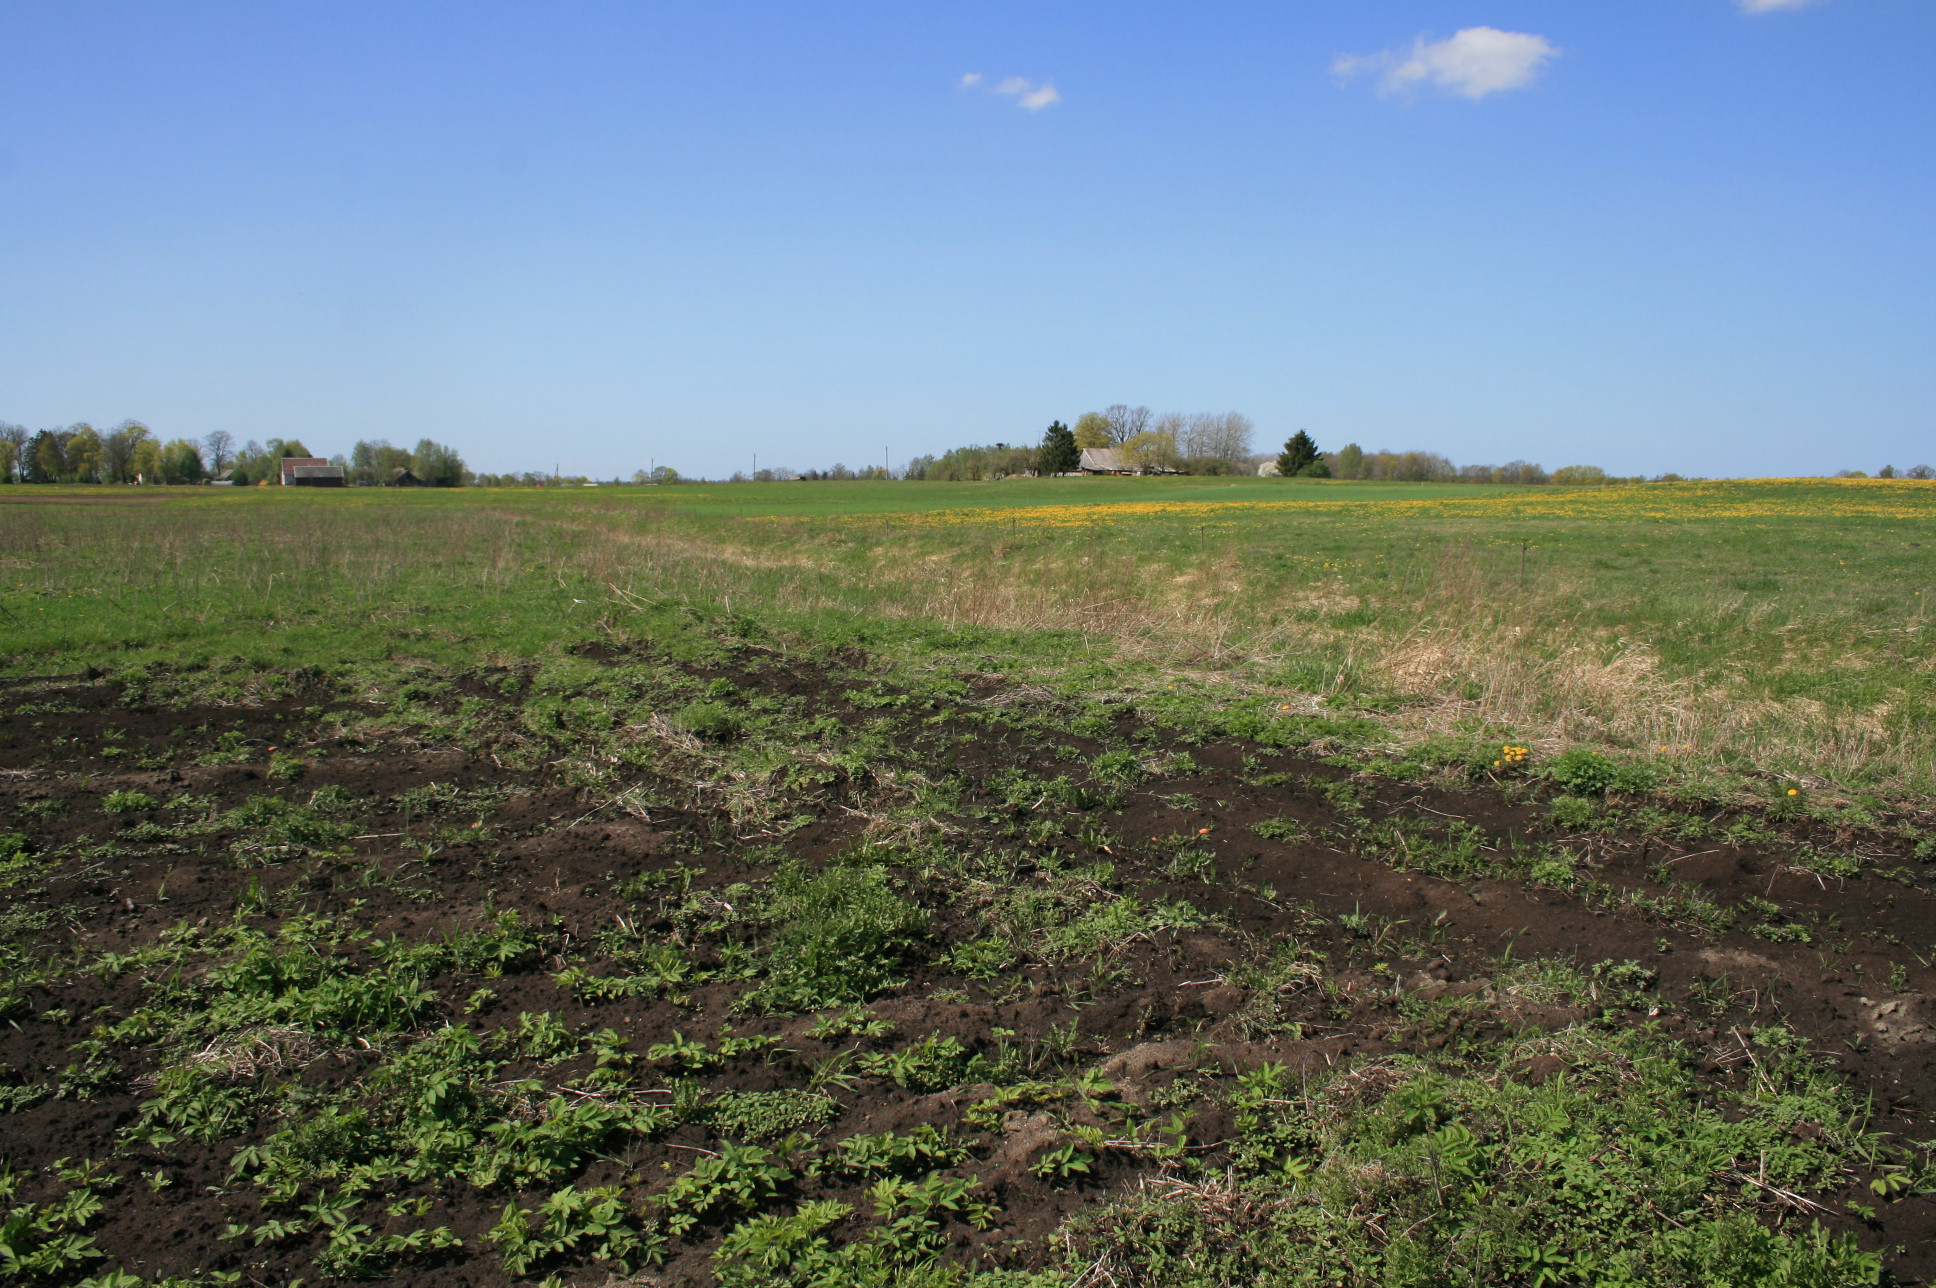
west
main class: Grassland
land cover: Spontaneously vegetated surfaces
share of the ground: 50 - 75 %
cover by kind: herbaceous plants 65 %, unconsolidated bare surface 35 %
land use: Fallow land
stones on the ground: < 10 %
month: May
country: LT
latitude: 56.2992
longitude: 21.5660
